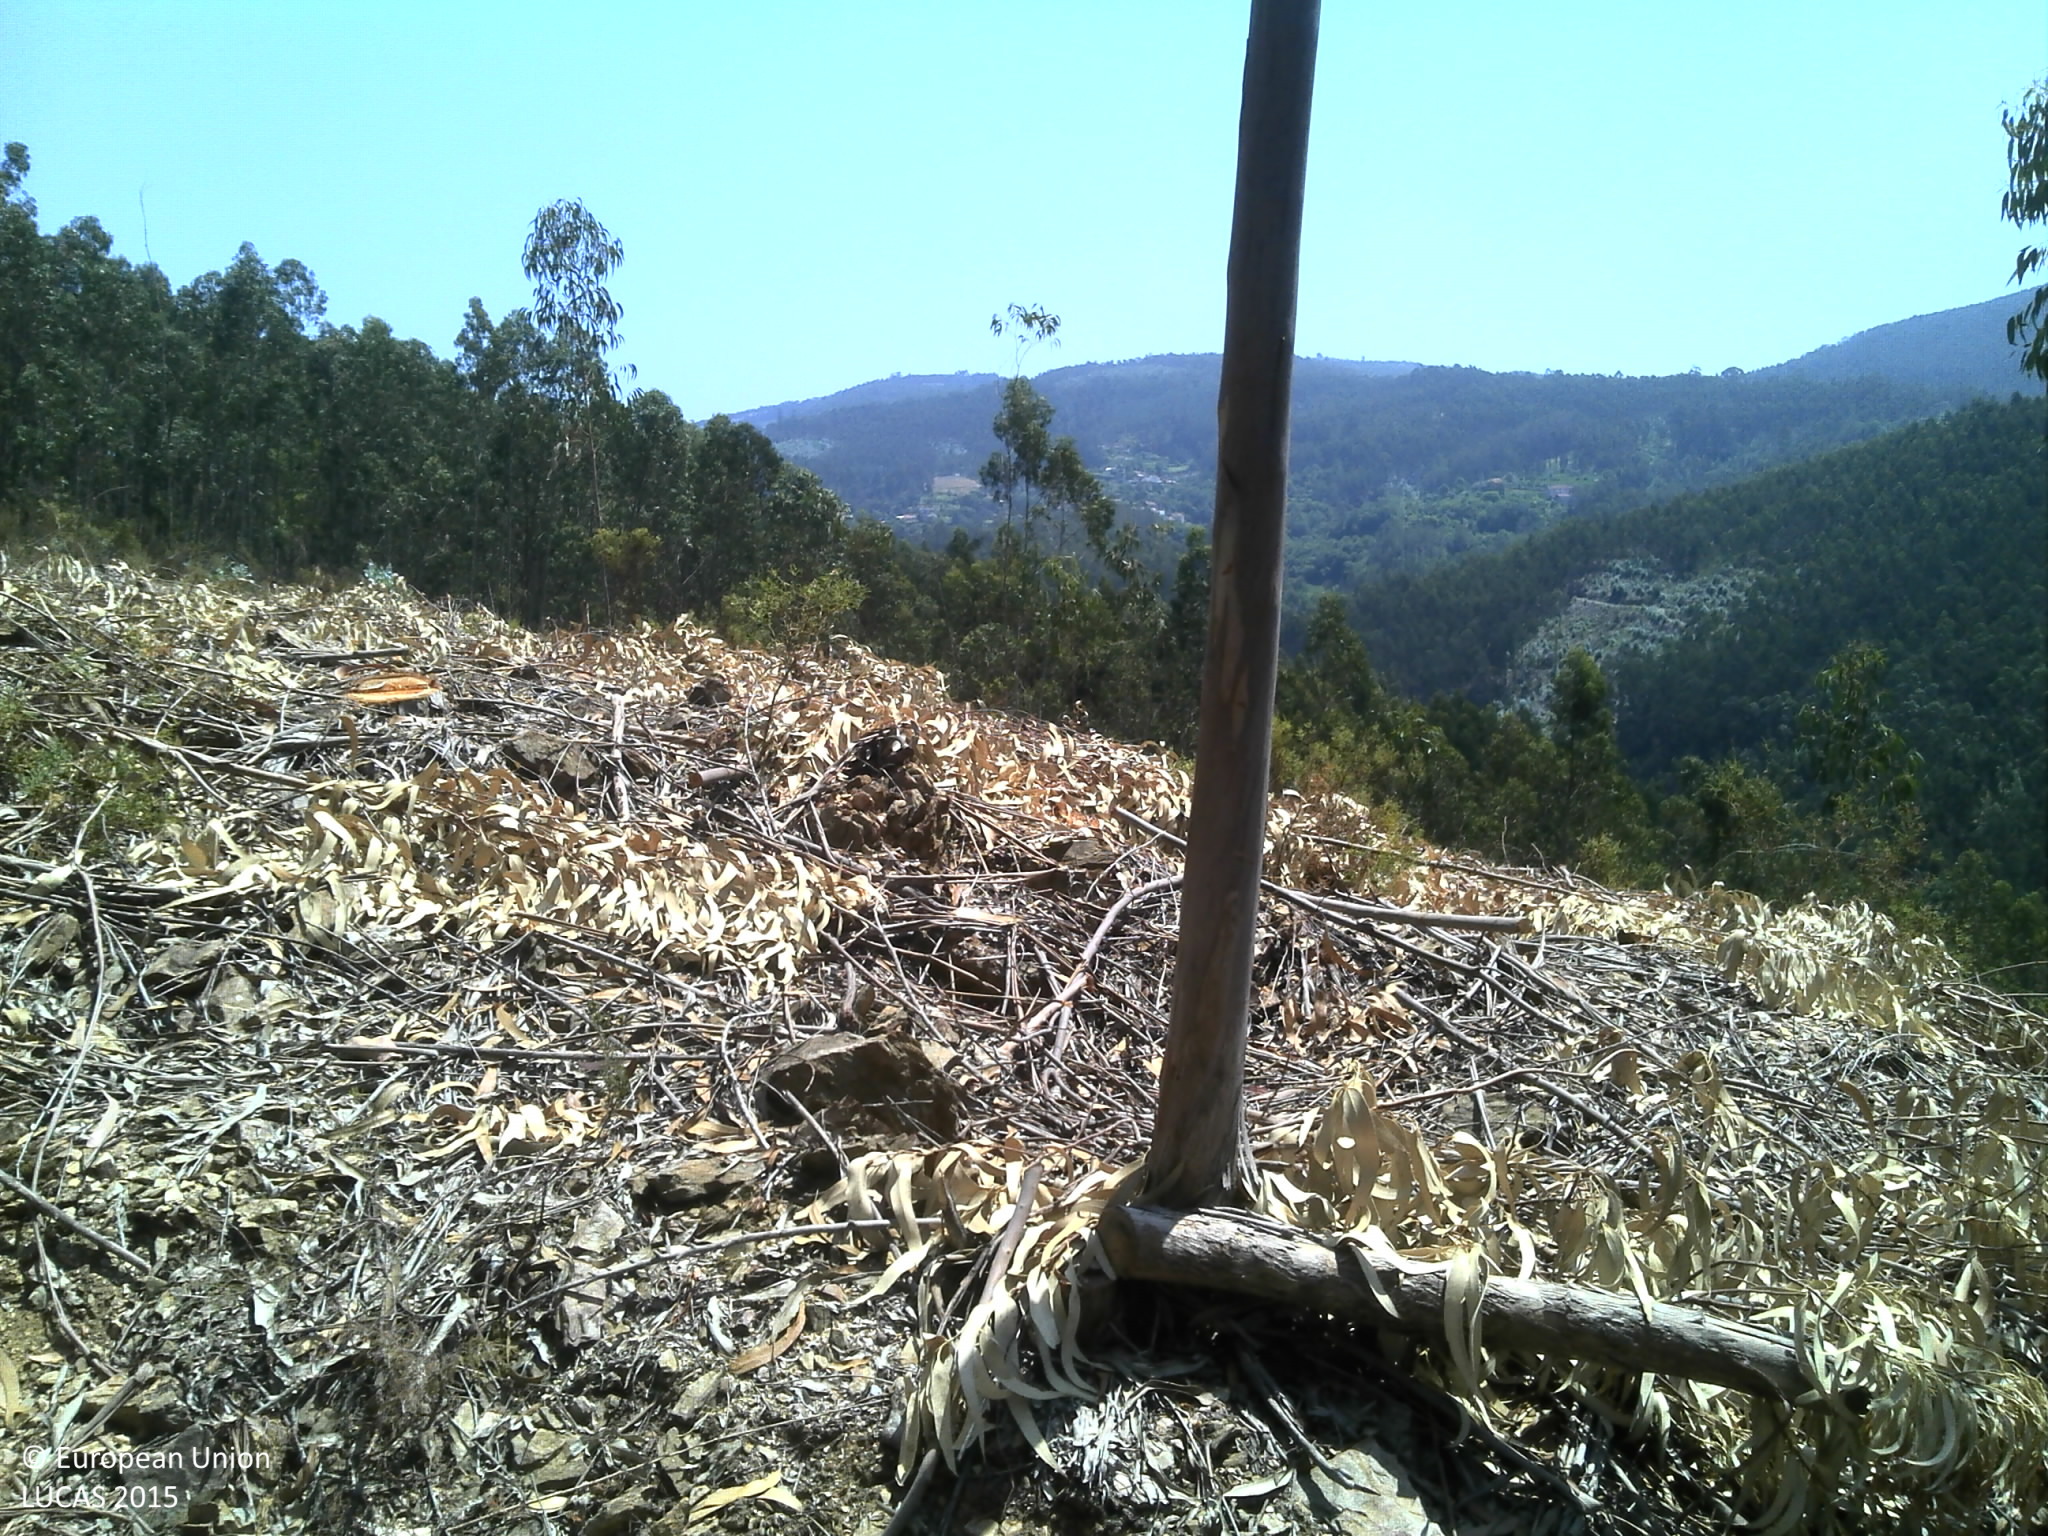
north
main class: Woodland
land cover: Broadleaved woodland
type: exotic forest
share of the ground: 50 - 75 %
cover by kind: broadleaved forest trees 70 %, shrubs 25 %, unconsolidated bare surface 5 %
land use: Forestry
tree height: > 5 m
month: July
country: PT
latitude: 40.6270
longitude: -8.3539
